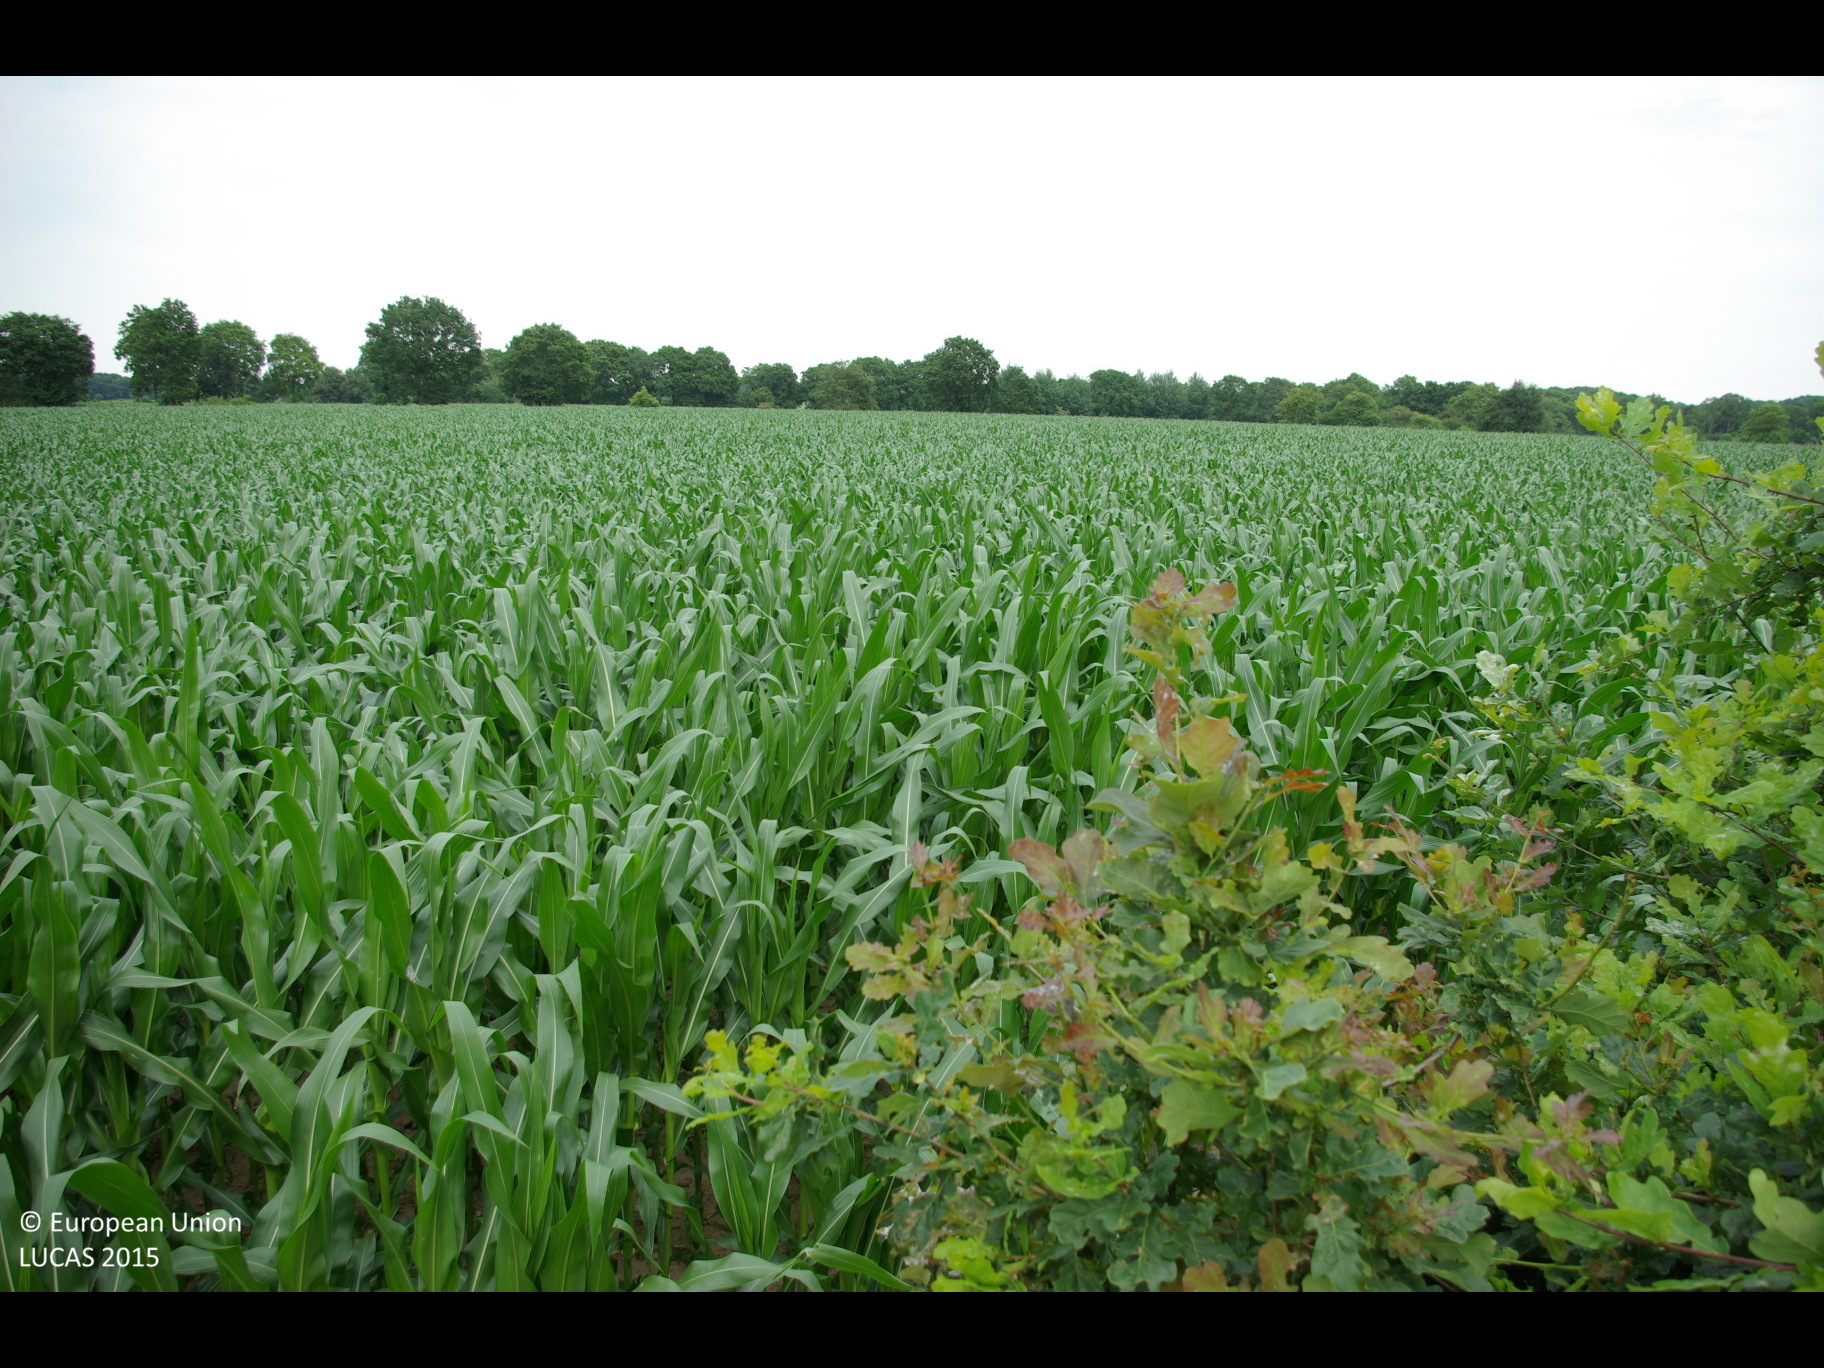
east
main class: Cropland
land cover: Maize
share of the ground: > 75 %
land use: Agriculture (excluding fallow land and kitchen gardens)
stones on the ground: 25 - 50 %
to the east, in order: Maize; Abandoned hedges; Maize; Abandoned hedges; Maize
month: July
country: DE
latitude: 54.2267
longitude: 9.3102
